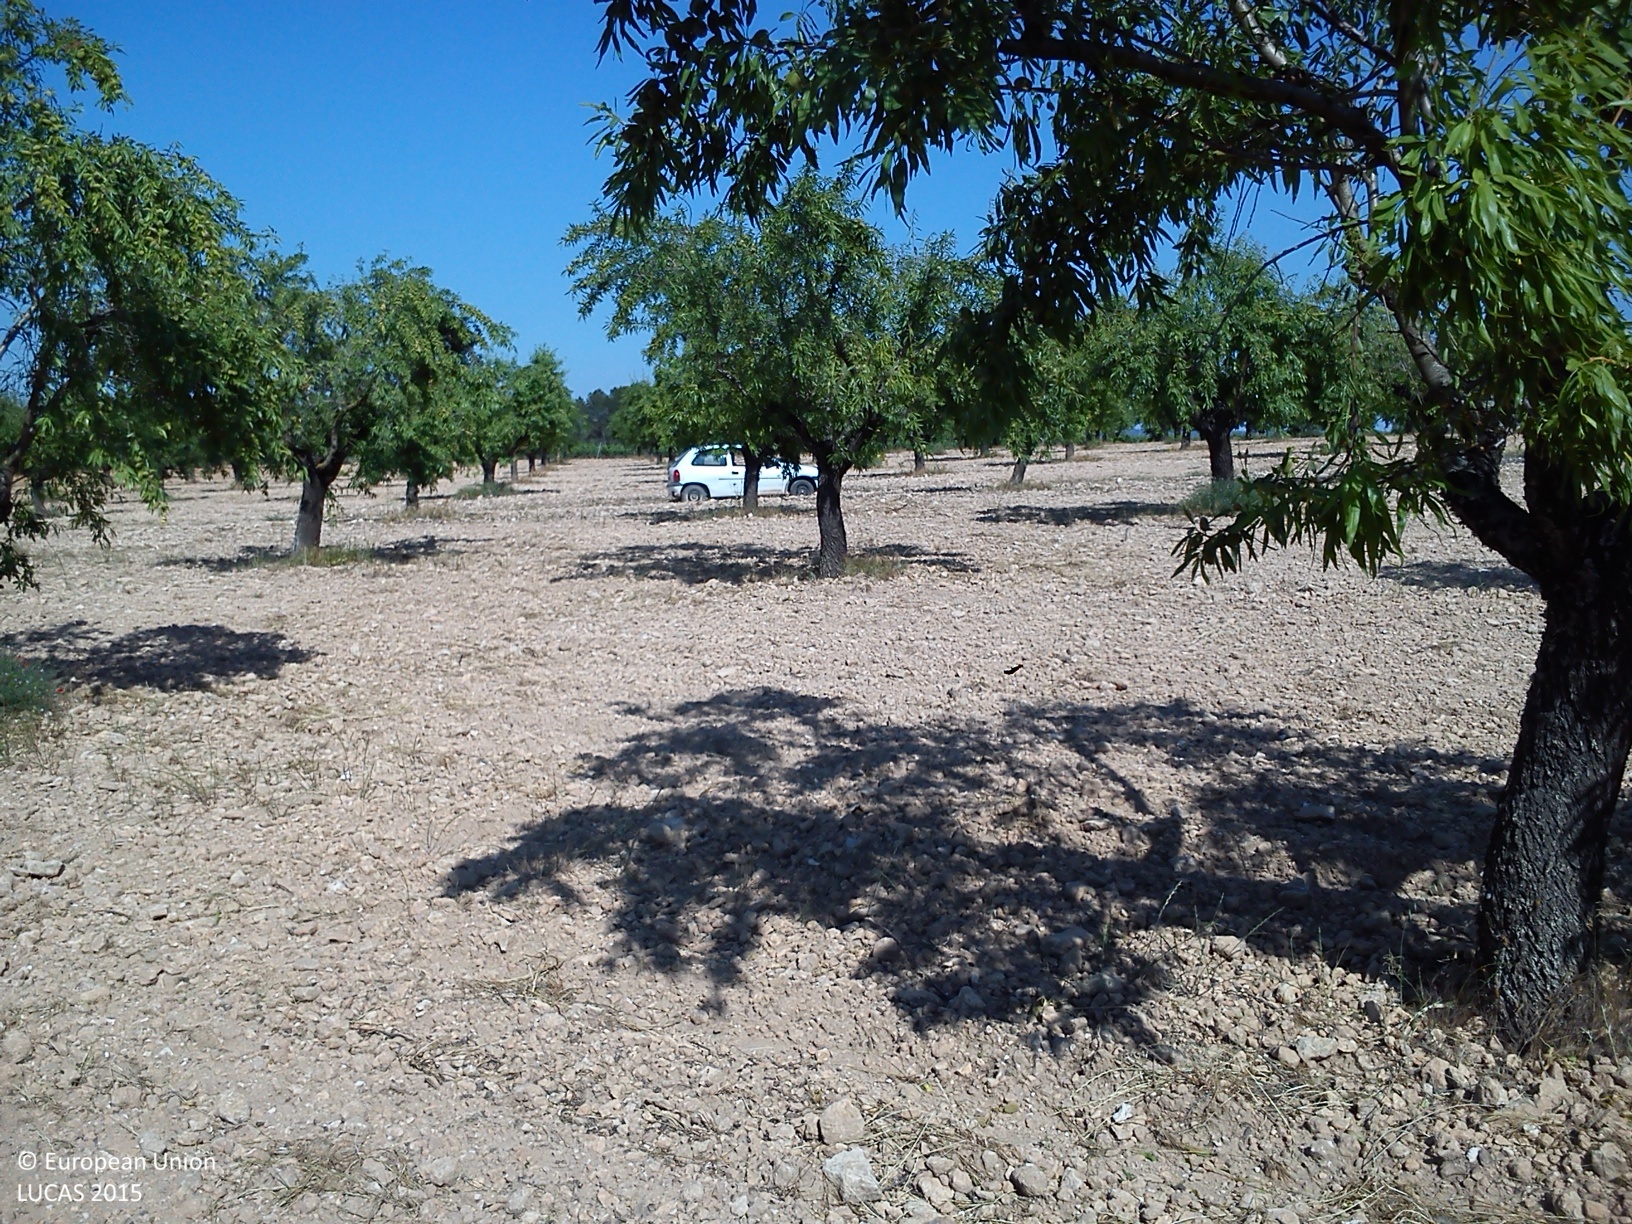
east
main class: Cropland
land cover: Nuts trees
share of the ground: 10 - 25 %
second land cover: Other bare soil
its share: > 75 %
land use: Agriculture (excluding fallow land and kitchen gardens)
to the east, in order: Nuts trees; Other bare soil; Tracks; Nuts trees; Vineyards; Shruby margins; Tracks; Pine dominated coniferous woodland
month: June
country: ES
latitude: 39.3251
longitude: -1.1006
